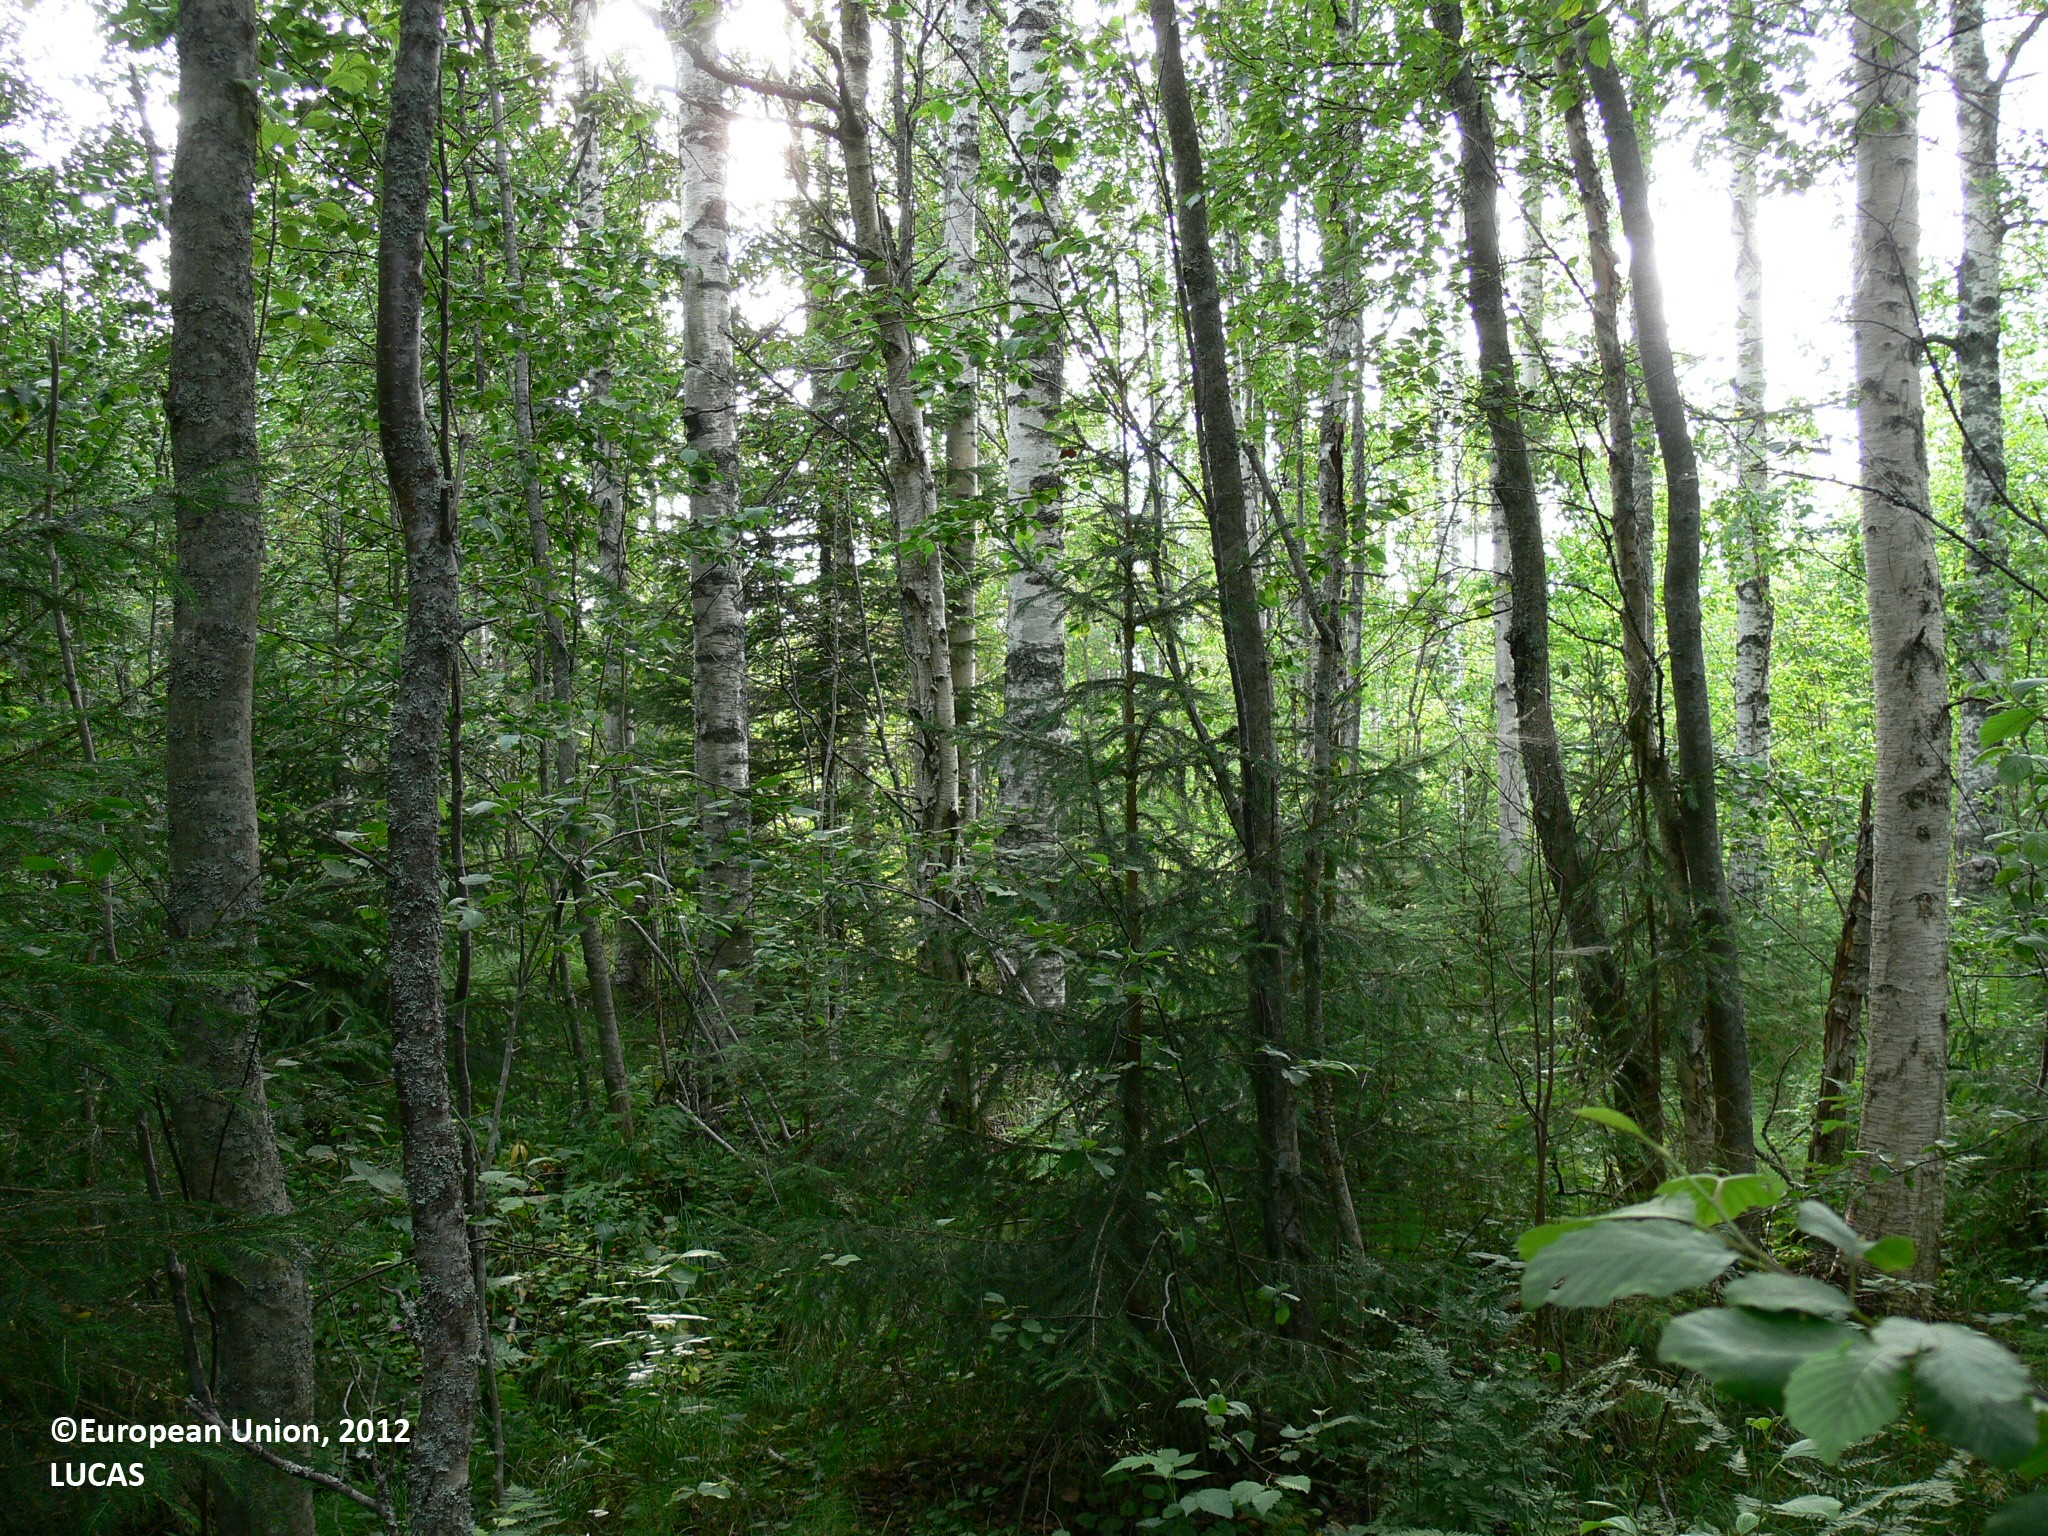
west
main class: Woodland
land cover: Other mixed woodland
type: boreal forest
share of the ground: > 75 %
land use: Forestry
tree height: > 5 m
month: July
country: FI
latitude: 63.1831
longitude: 29.5242
